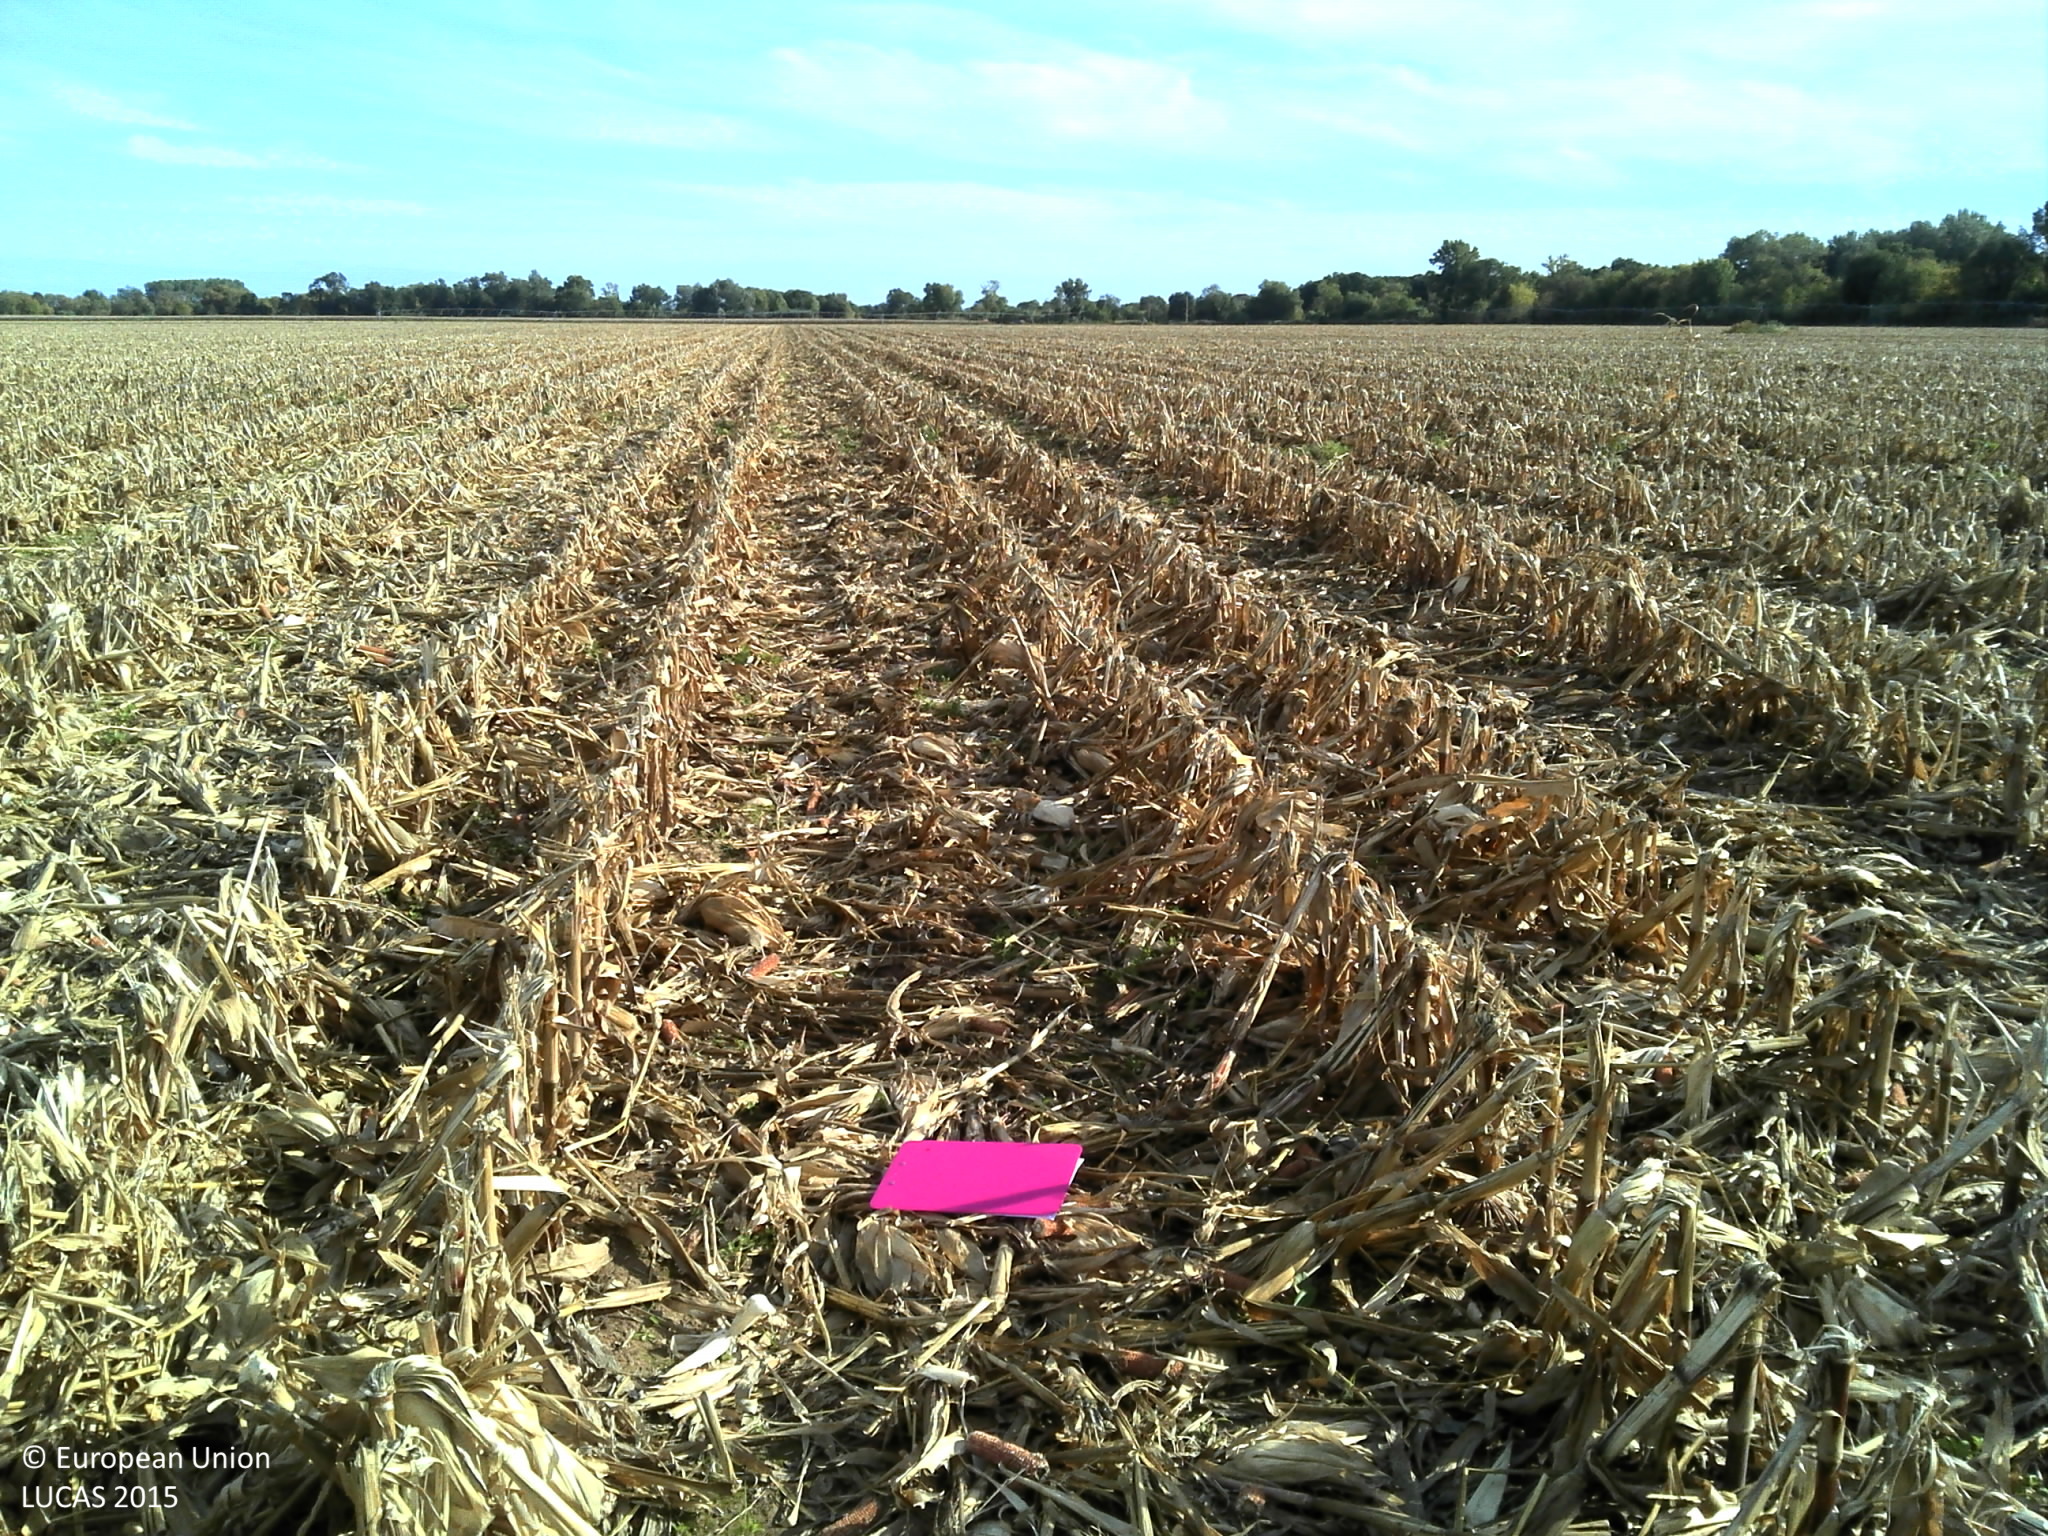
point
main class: Cropland
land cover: Maize
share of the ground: 50 - 75 %
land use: Agriculture (excluding fallow land and kitchen gardens)
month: October
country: FR
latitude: 43.4002
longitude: 3.4285
